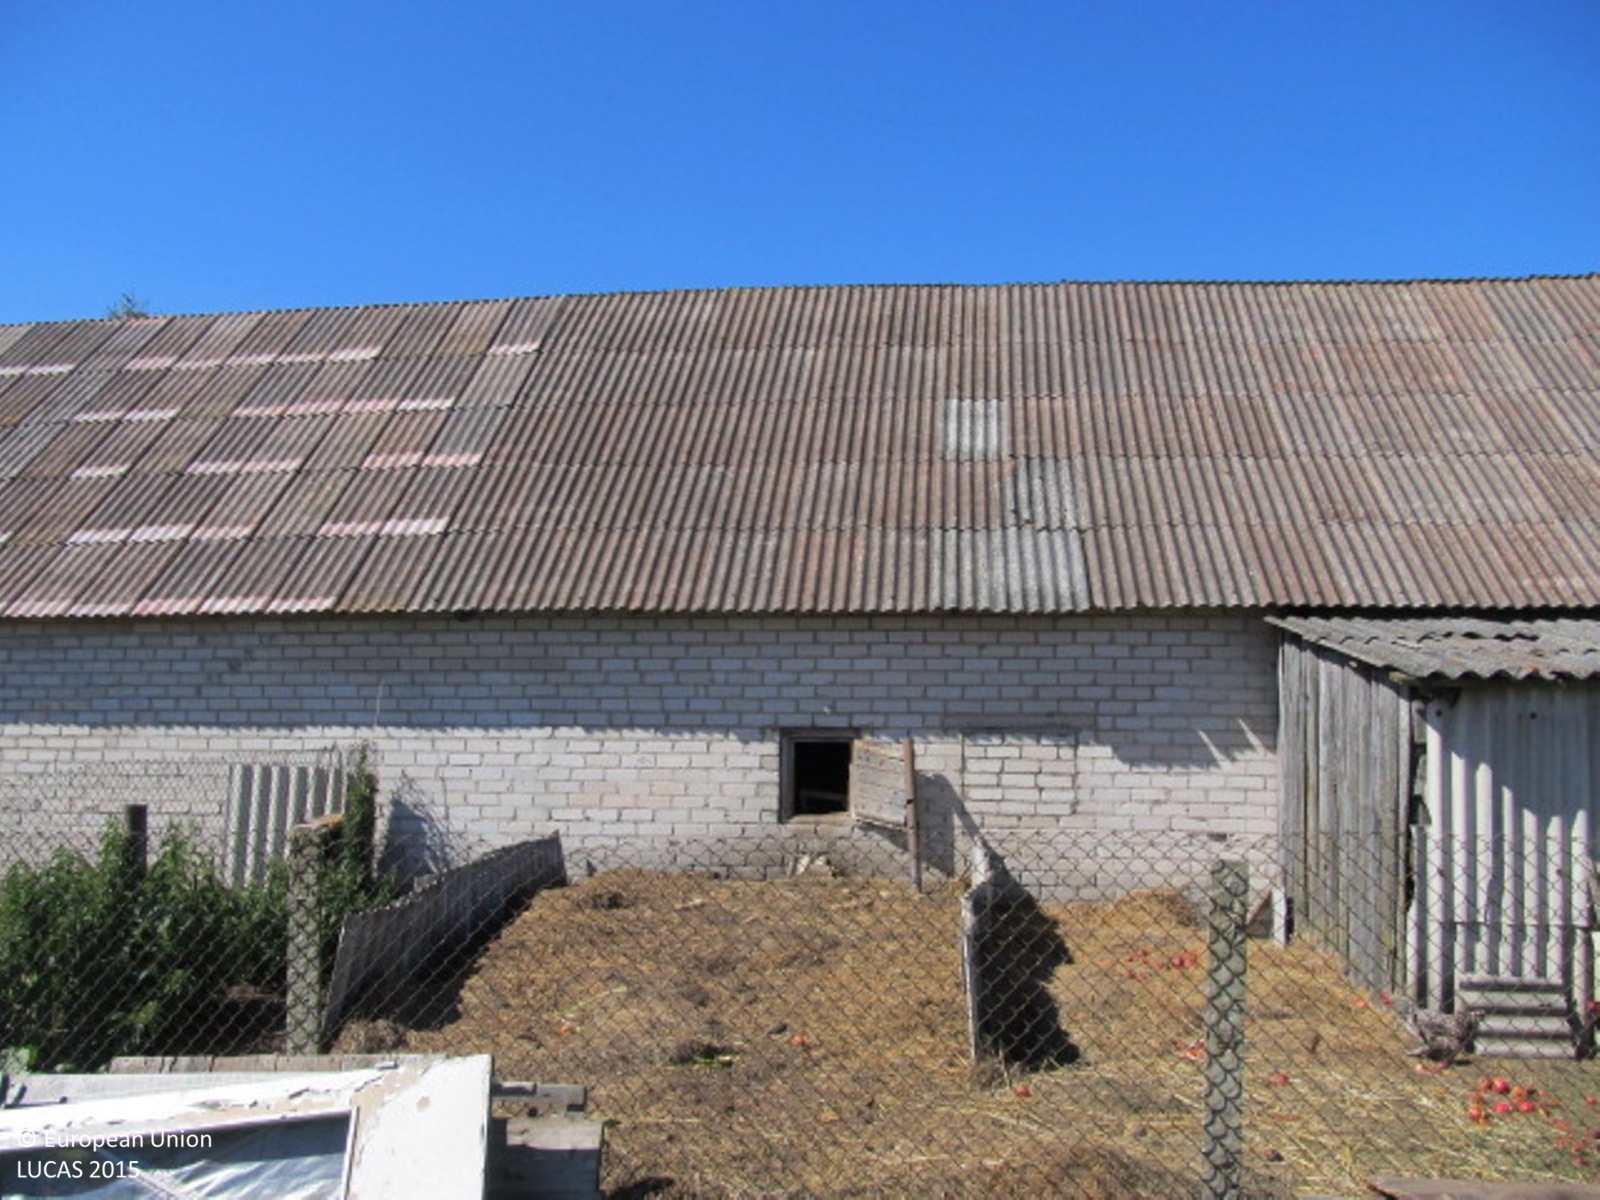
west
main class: Grassland
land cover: Grassland without tree/shrub cover
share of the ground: > 75 %
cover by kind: herbaceous plants 100 %
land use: Agriculture (excluding fallow land and kitchen gardens)
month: August
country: LT
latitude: 56.1884
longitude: 22.5471
